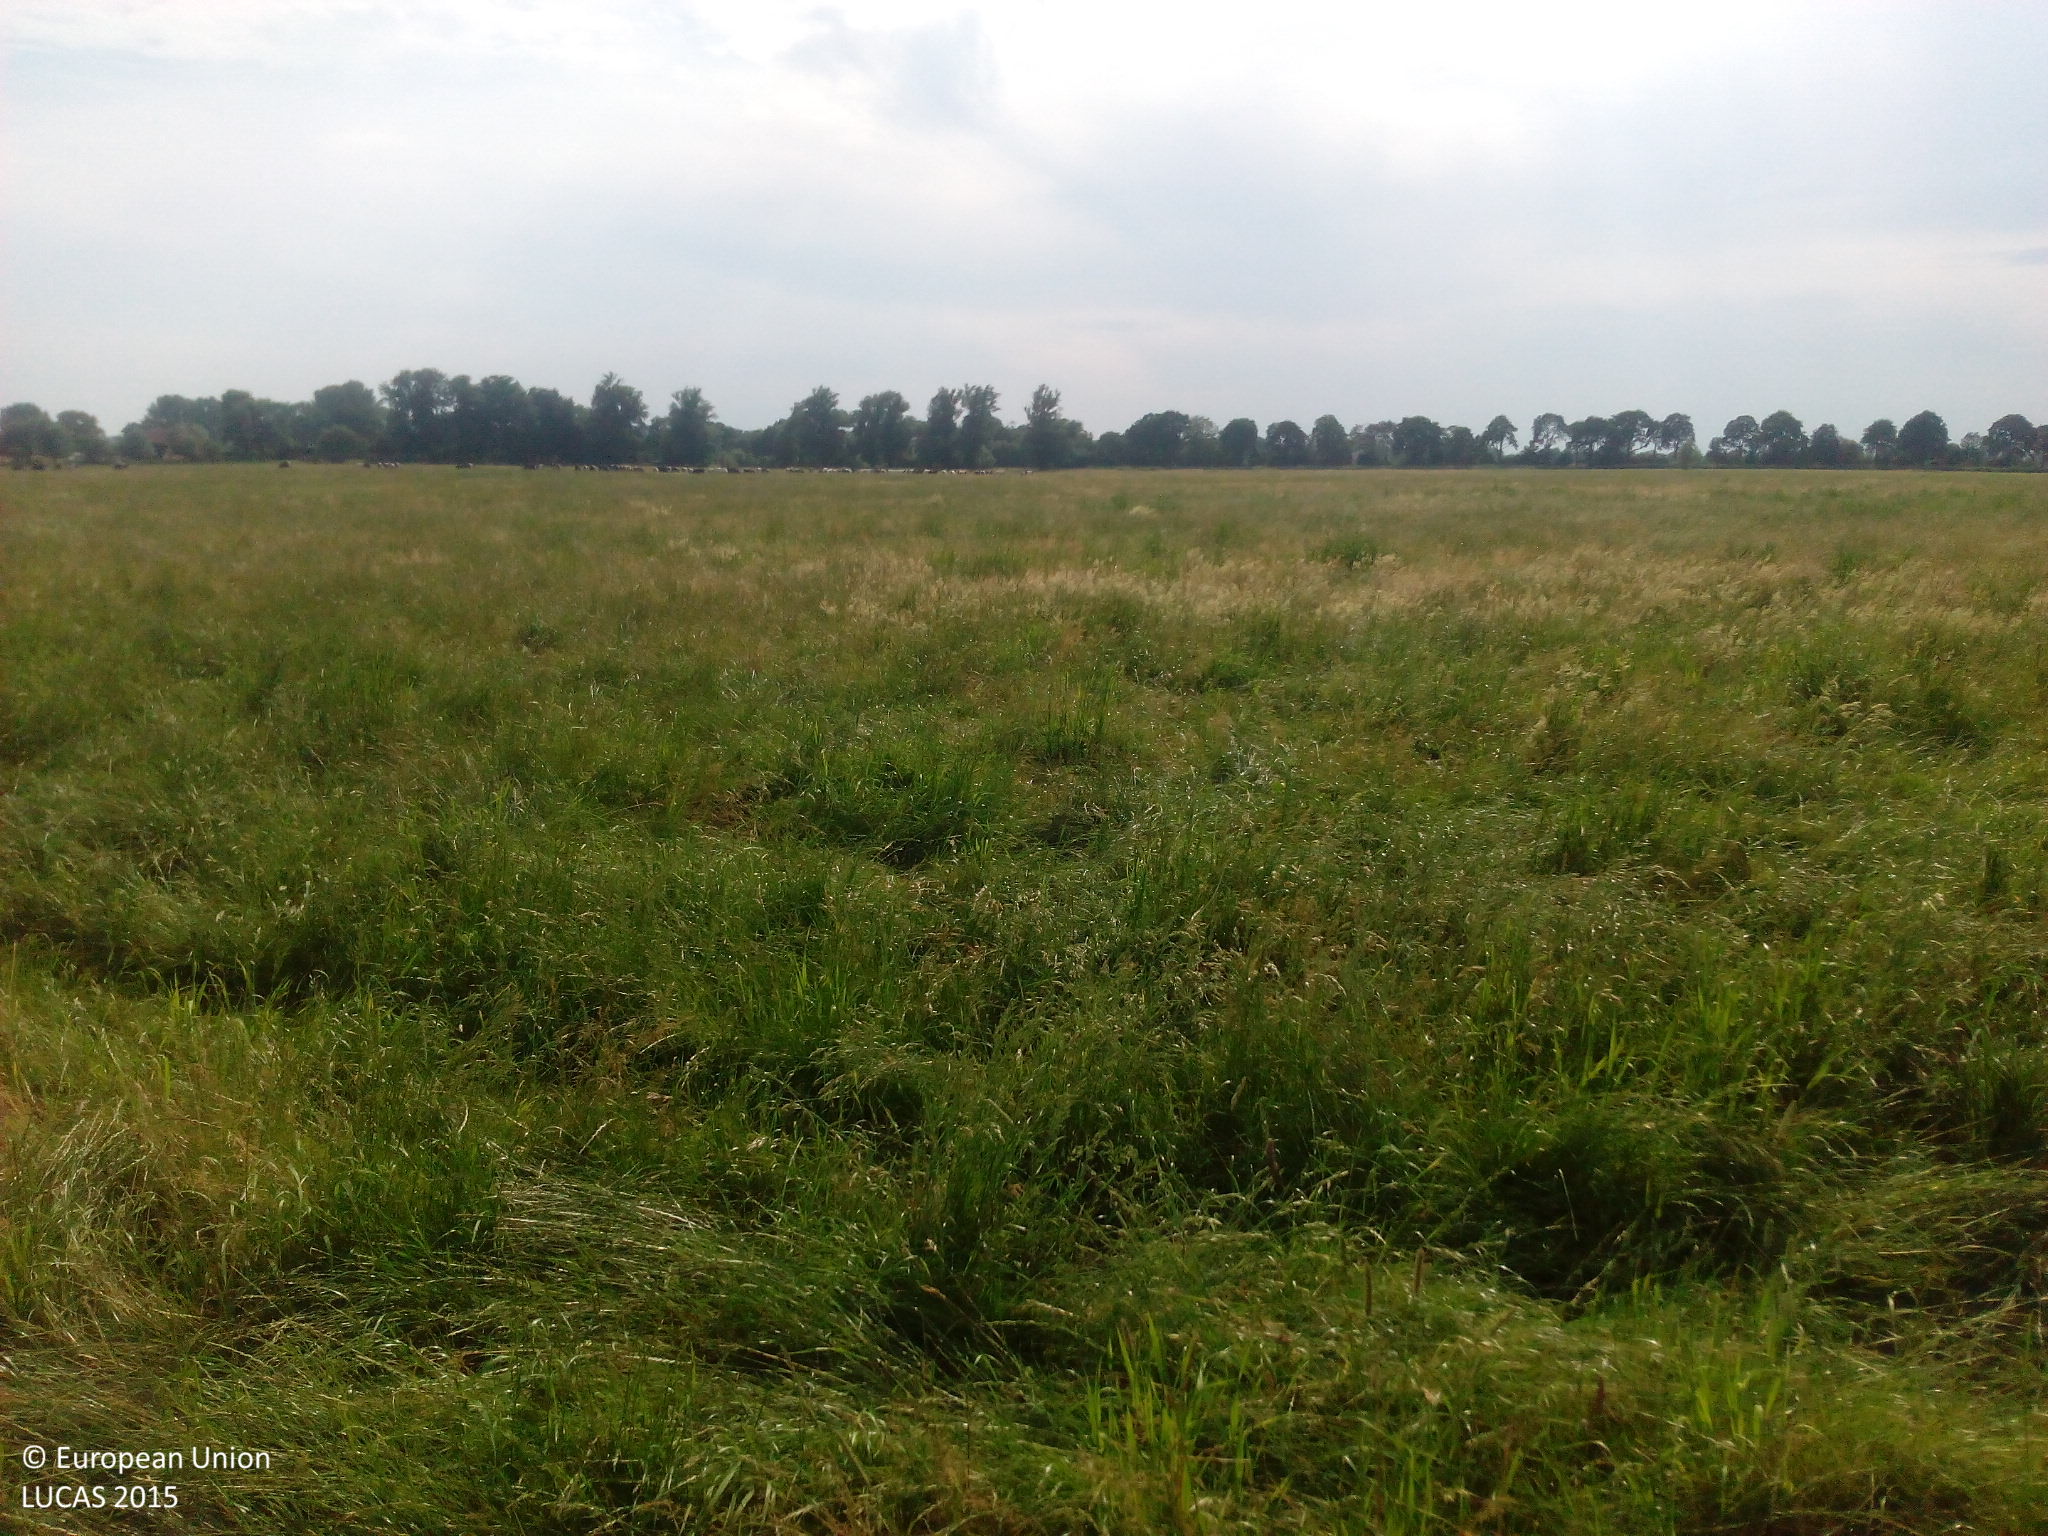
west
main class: Grassland
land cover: Grassland without tree/shrub cover
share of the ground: > 75 %
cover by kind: herbaceous plants 100 %
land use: Agriculture (excluding fallow land and kitchen gardens)
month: July
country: DE
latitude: 52.7659
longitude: 12.4449
